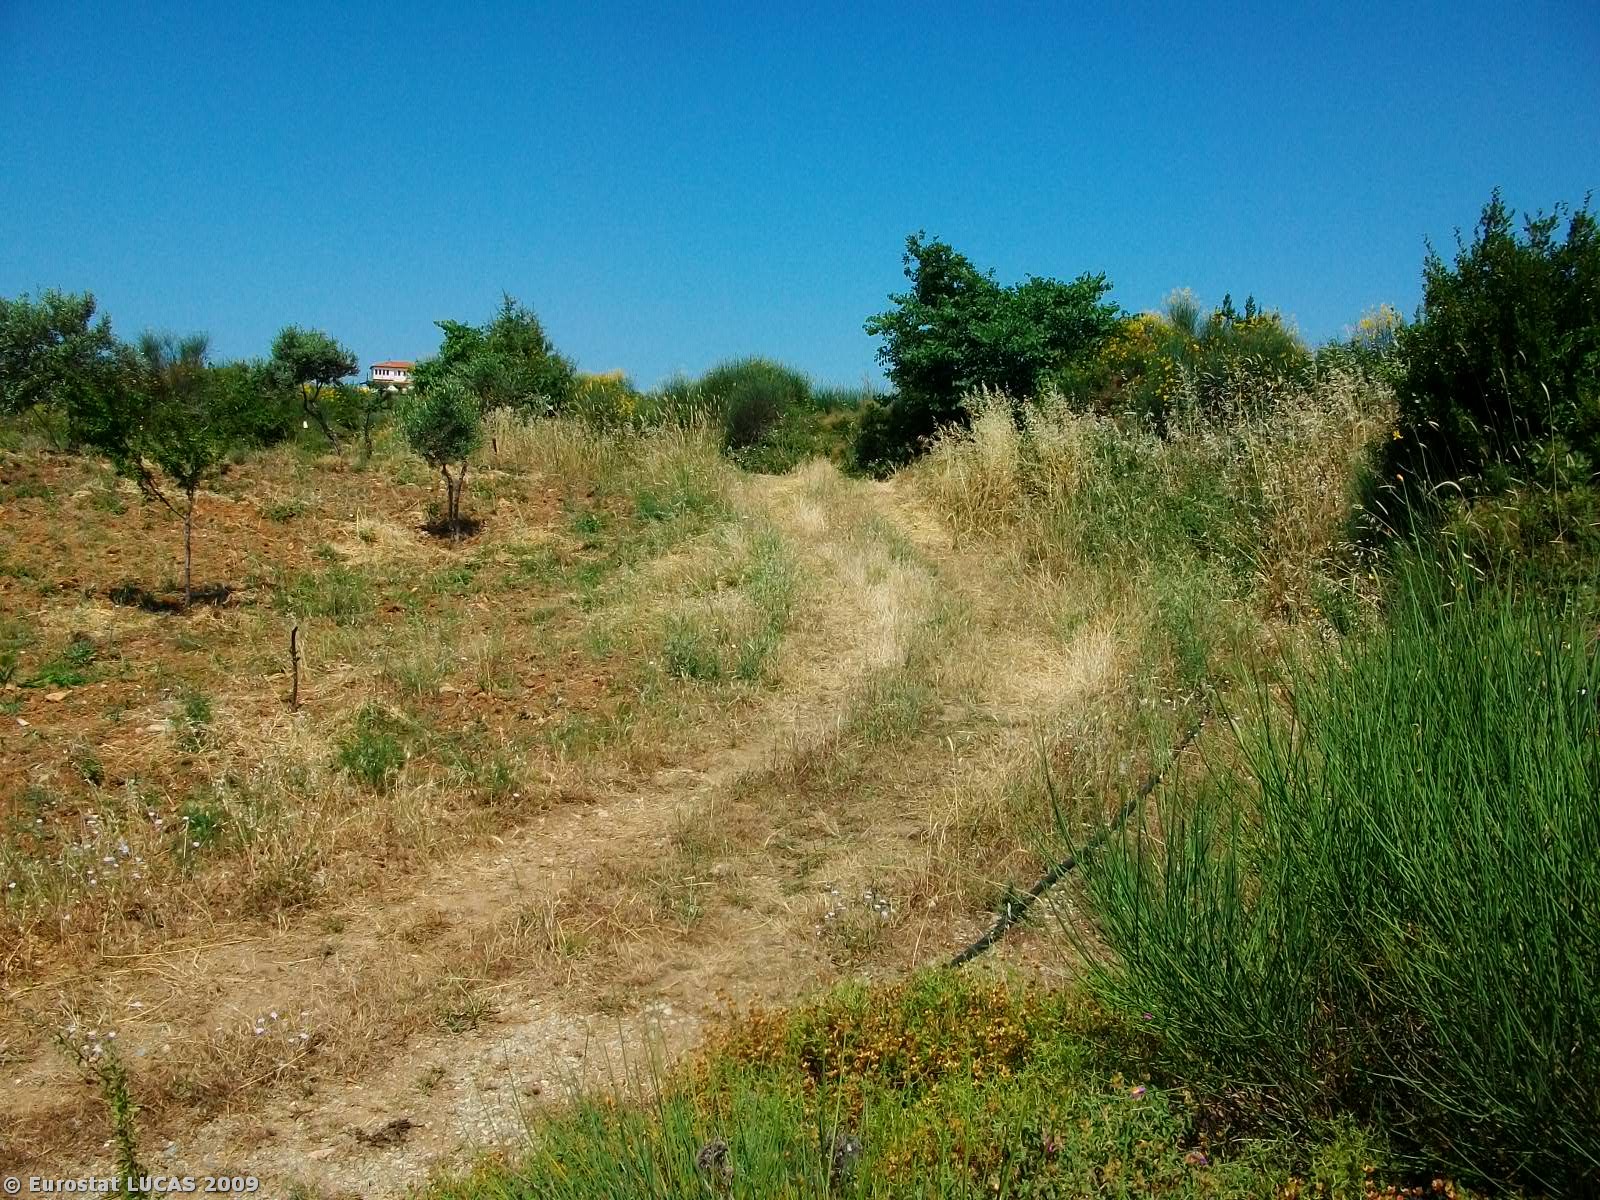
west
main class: Shrubland
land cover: Shrubland without tree cover
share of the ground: > 75 %
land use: Unused
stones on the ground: > 50 %
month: June
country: GR
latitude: 39.2203
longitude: 23.2316
